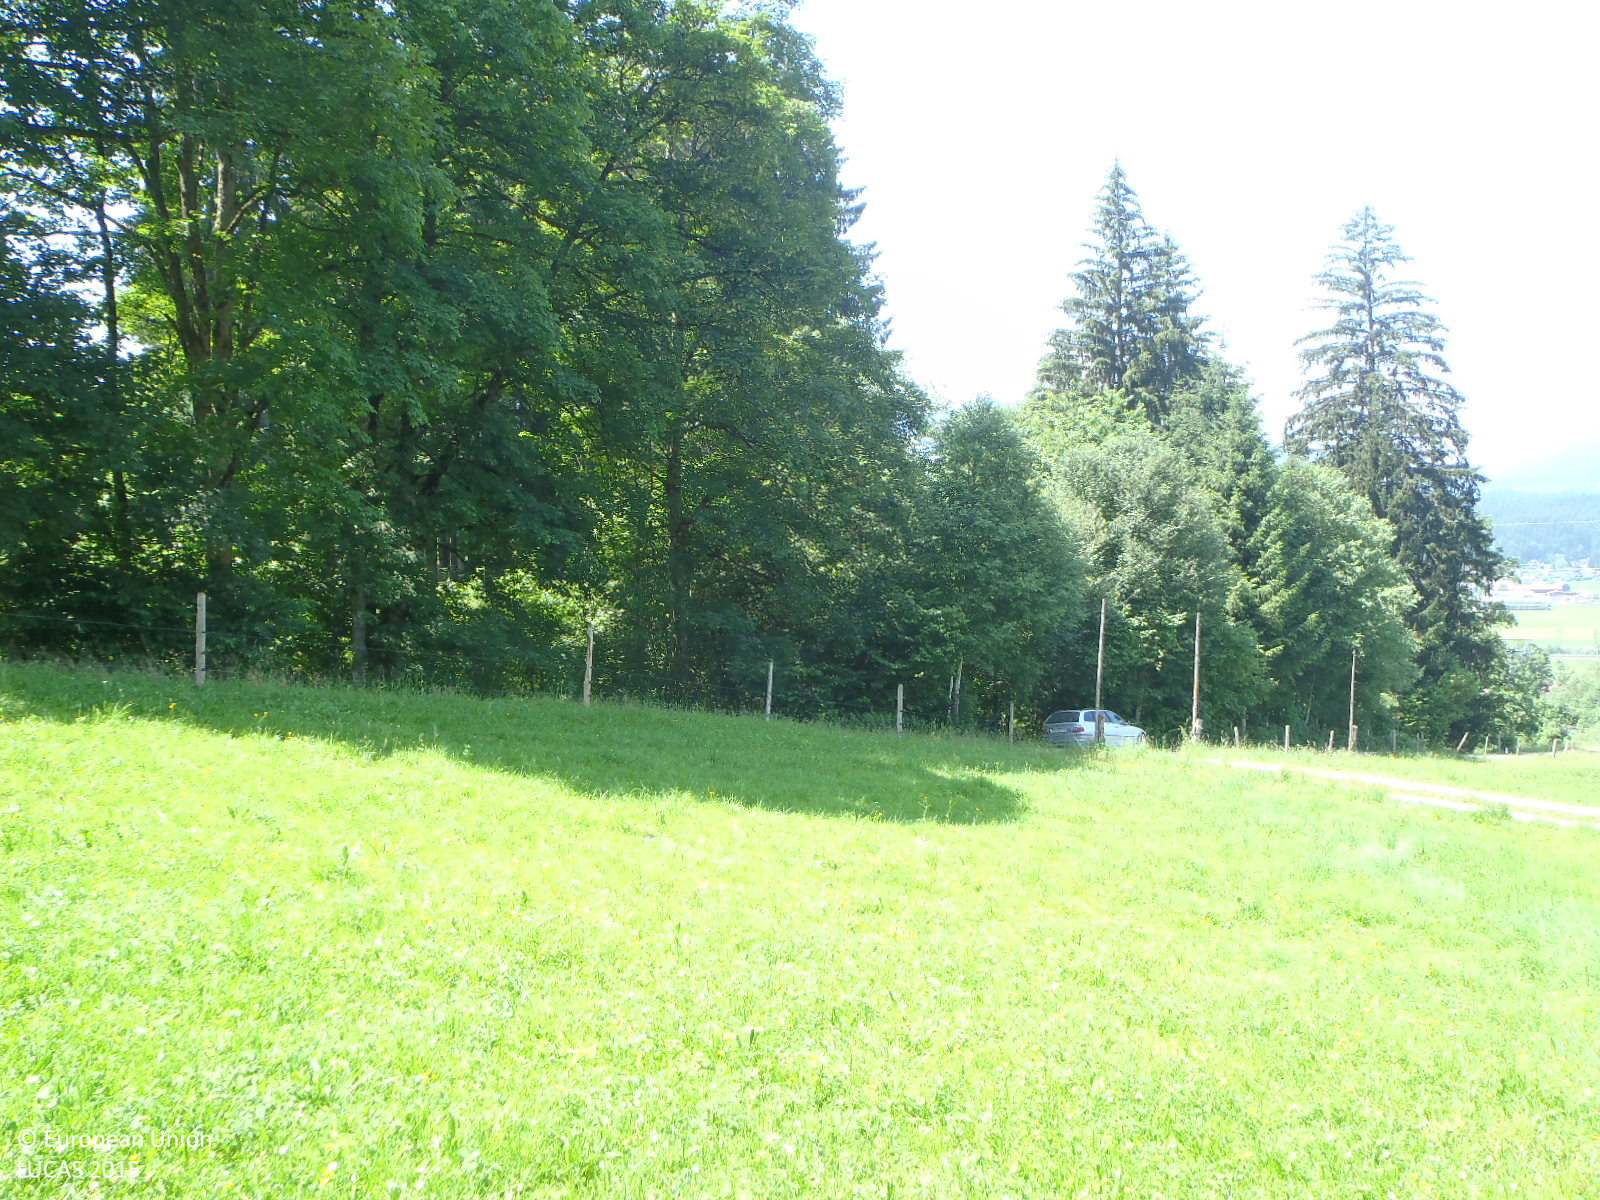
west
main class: Grassland
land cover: Grassland without tree/shrub cover
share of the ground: > 75 %
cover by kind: herbaceous plants 100 %
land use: Agriculture (excluding fallow land and kitchen gardens)
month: July
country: AT
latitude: 47.4952
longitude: 12.4009
